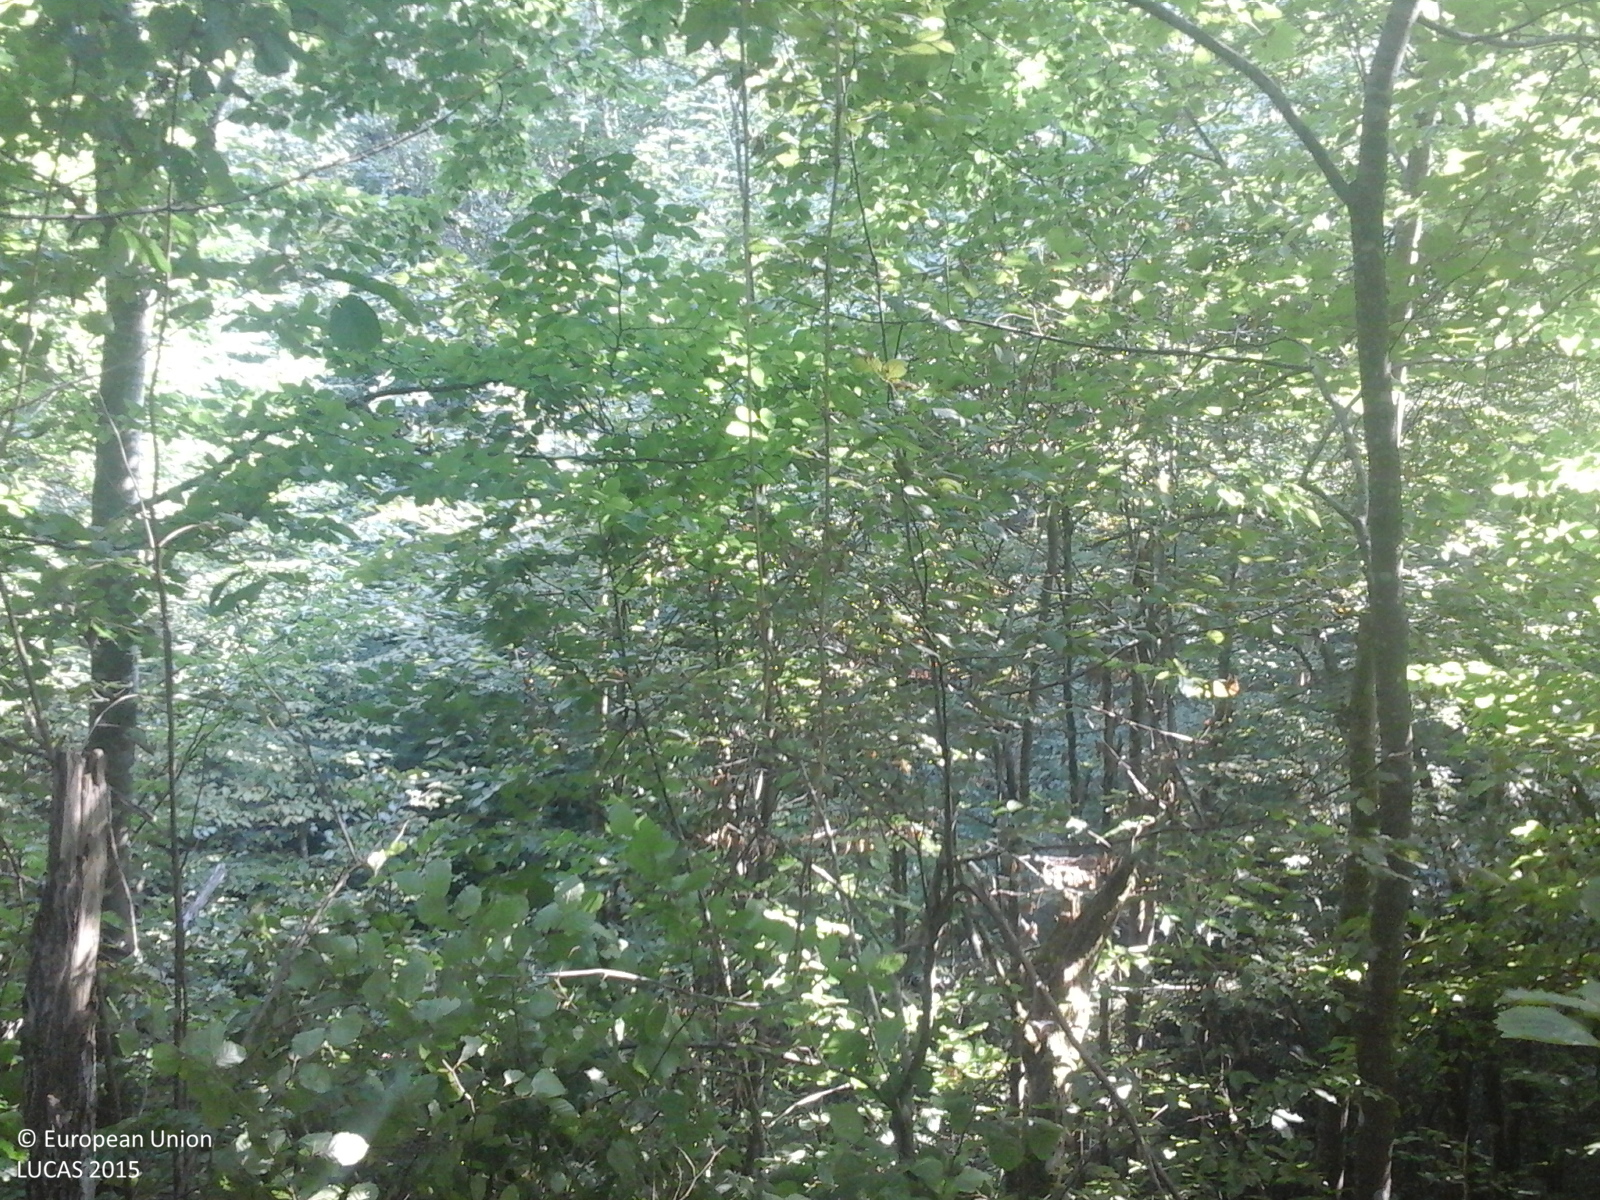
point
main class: Woodland
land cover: Broadleaved woodland
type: beech forest
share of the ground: > 75 %
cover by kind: broadleaved forest trees 100 %
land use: Forestry
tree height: > 5 m
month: August
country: RO
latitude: 46.4340
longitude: 22.3475
